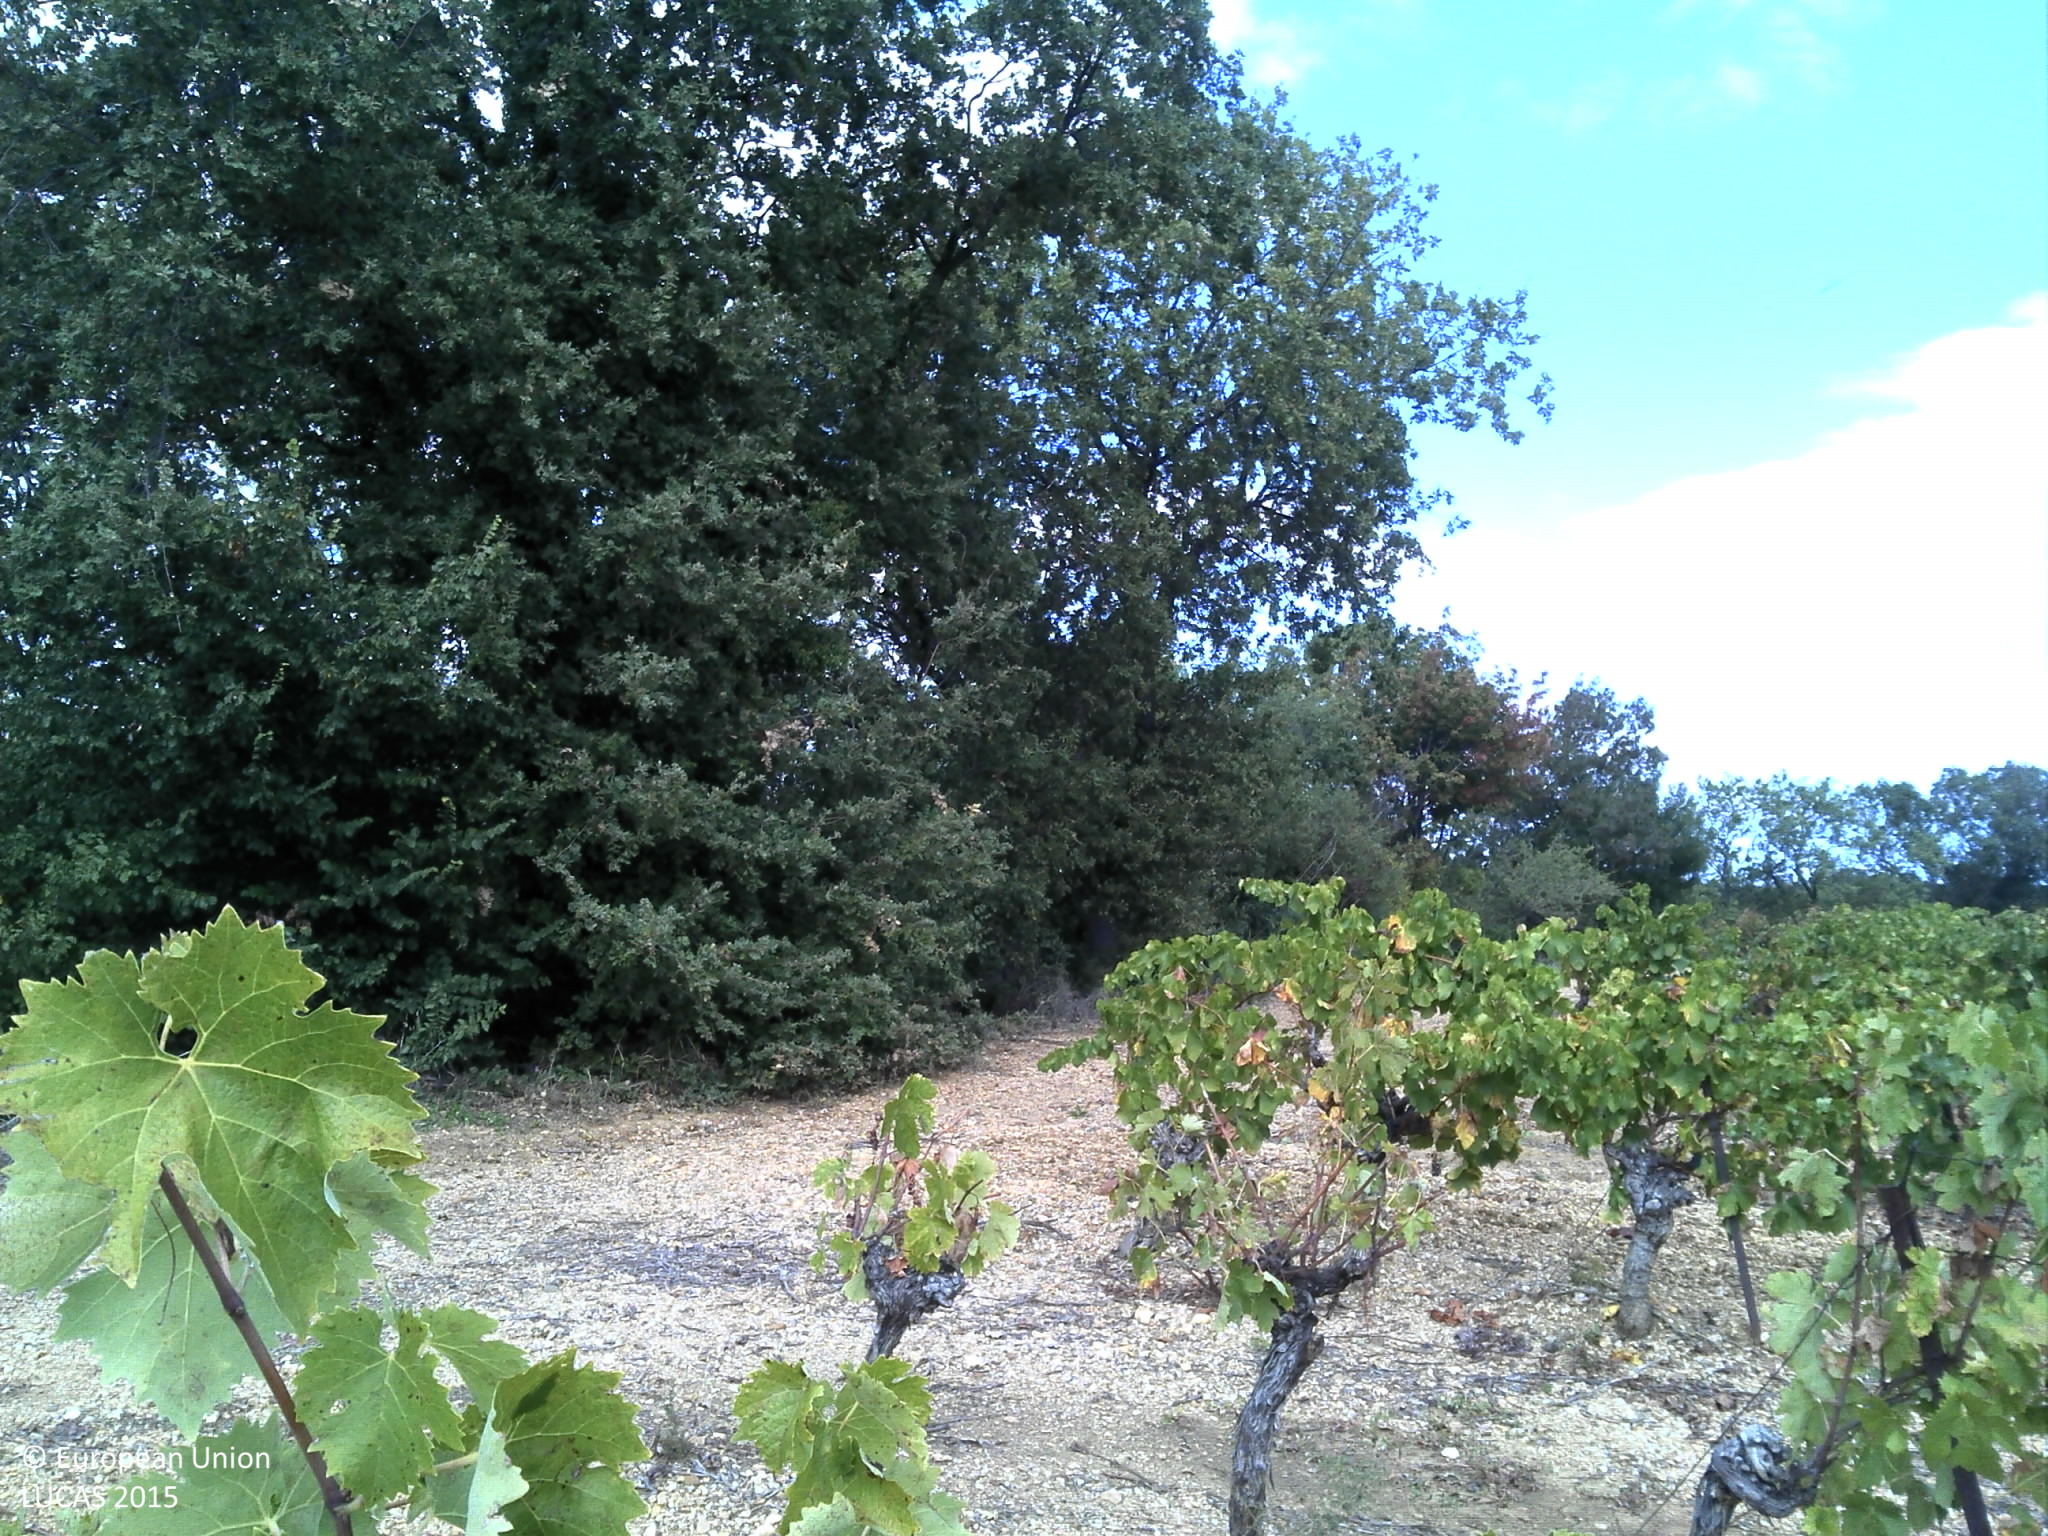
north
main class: Cropland
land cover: Vineyards
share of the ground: 10 - 25 %
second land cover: Other bare soil
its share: > 75 %
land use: Agriculture (excluding fallow land and kitchen gardens)
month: October
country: FR
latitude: 43.4298
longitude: 3.3261
